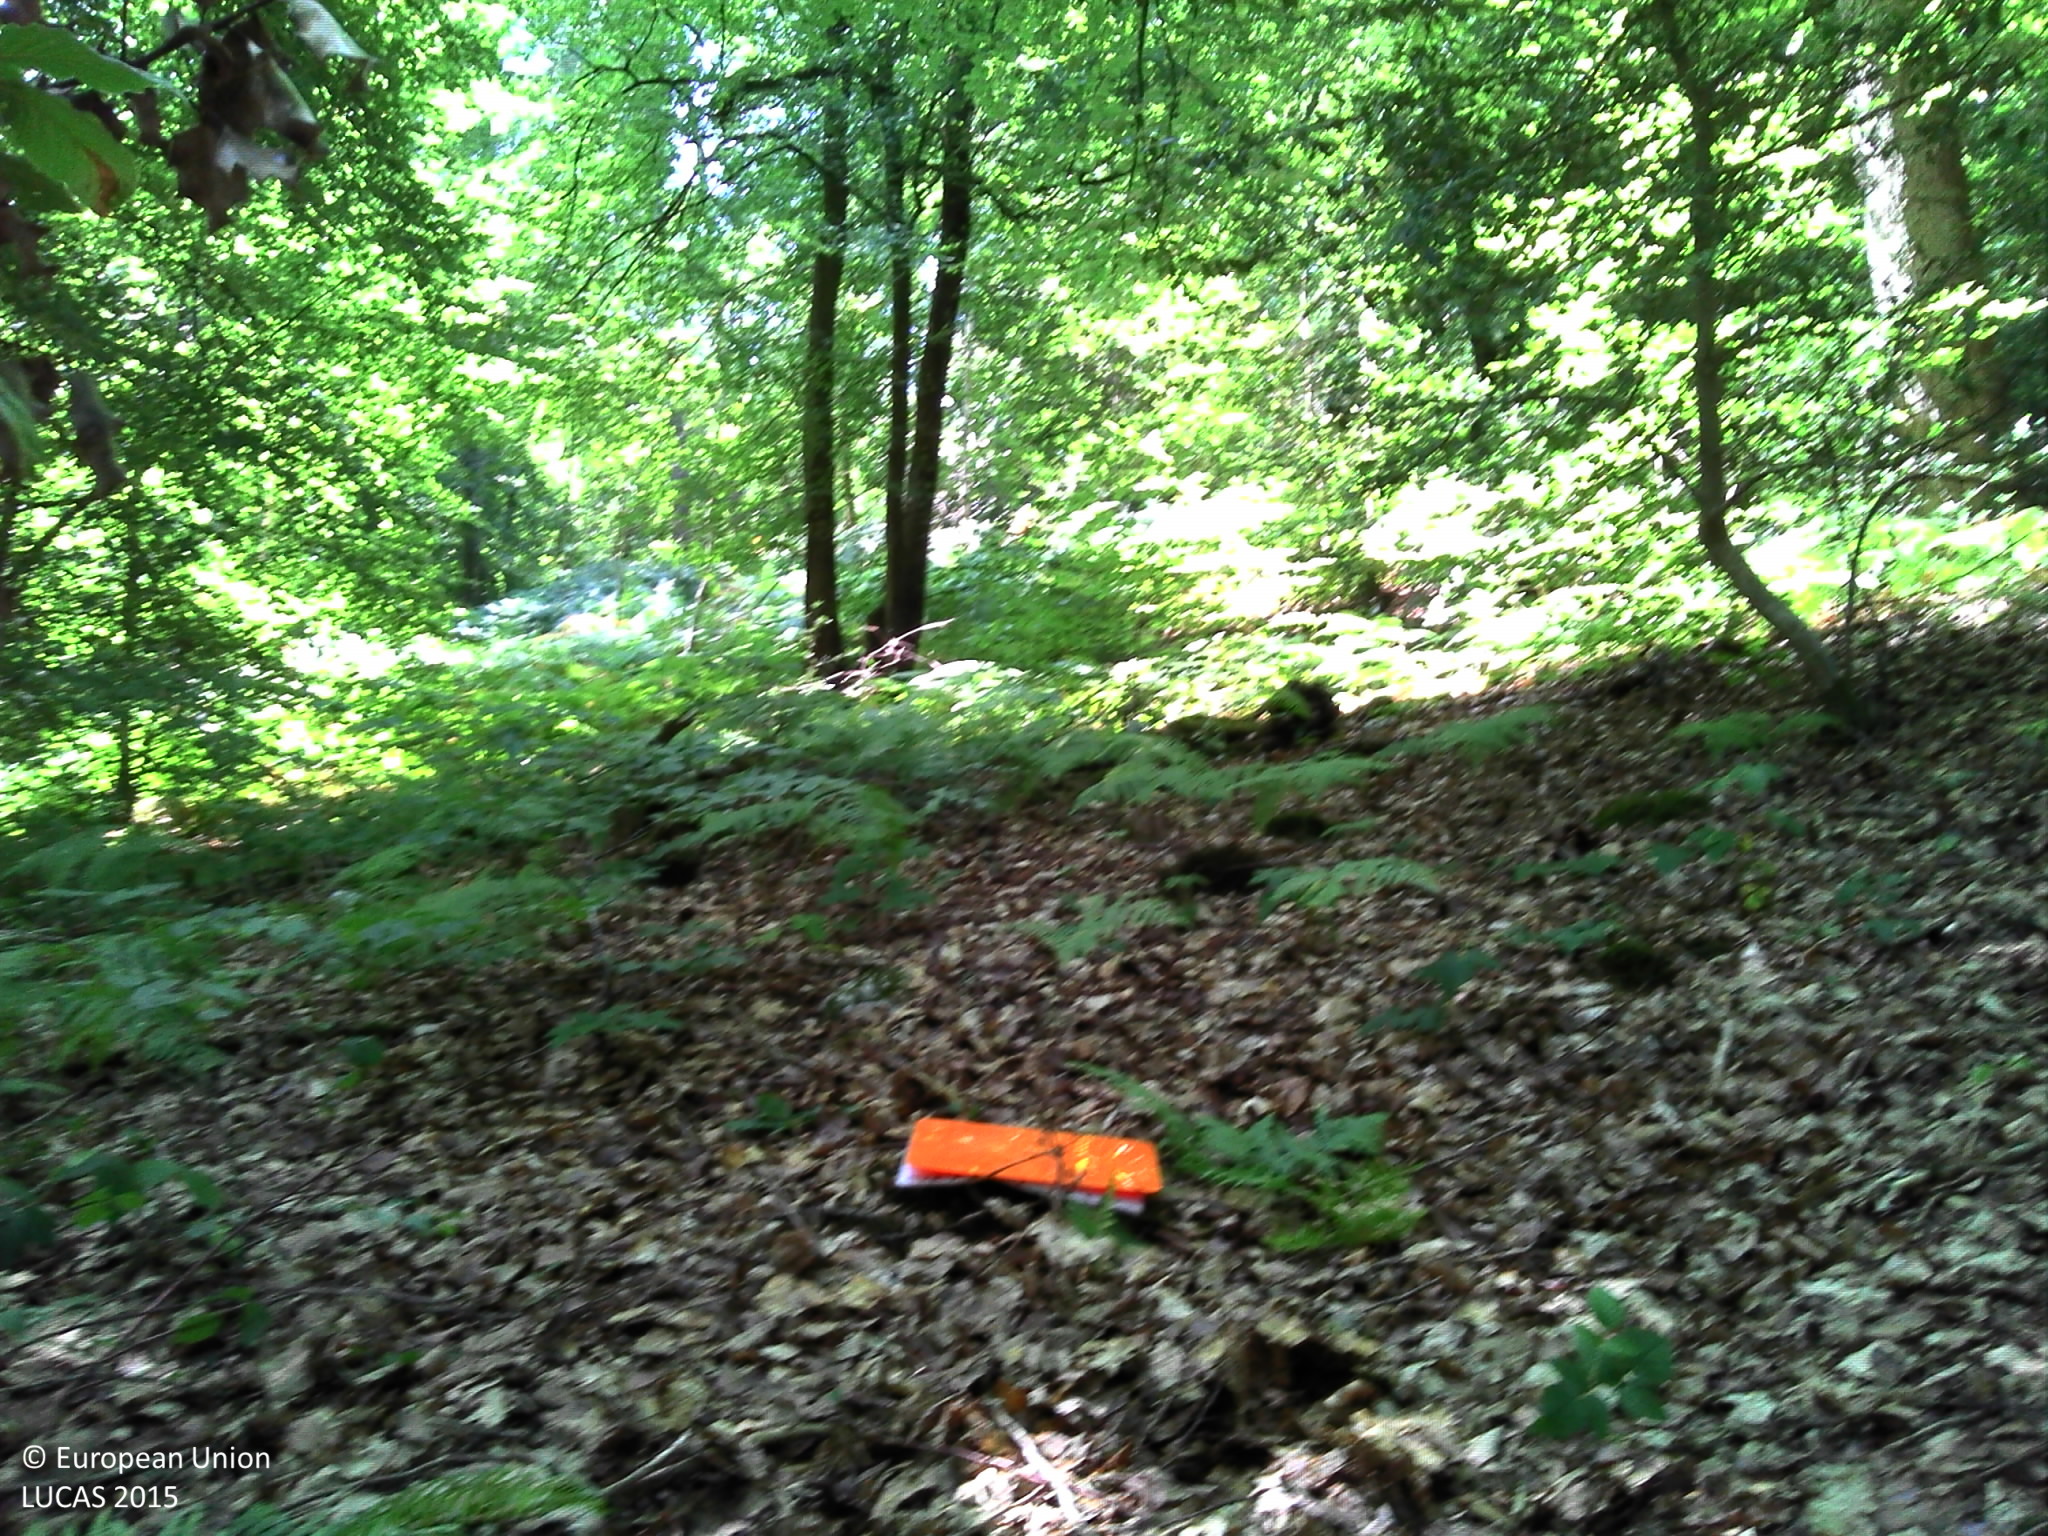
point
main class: Woodland
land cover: Broadleaved woodland
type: acidophilous oak and oak-birch forest
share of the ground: > 75 %
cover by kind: broadleaved forest trees 40 %, herbaceous plants 30 %, lichens and mosses 10 %, unconsolidated bare surface 10 %, consolidated bare surface 5 %
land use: Forestry
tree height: > 5 m
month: August
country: FR
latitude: 49.1335
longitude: 4.1707
